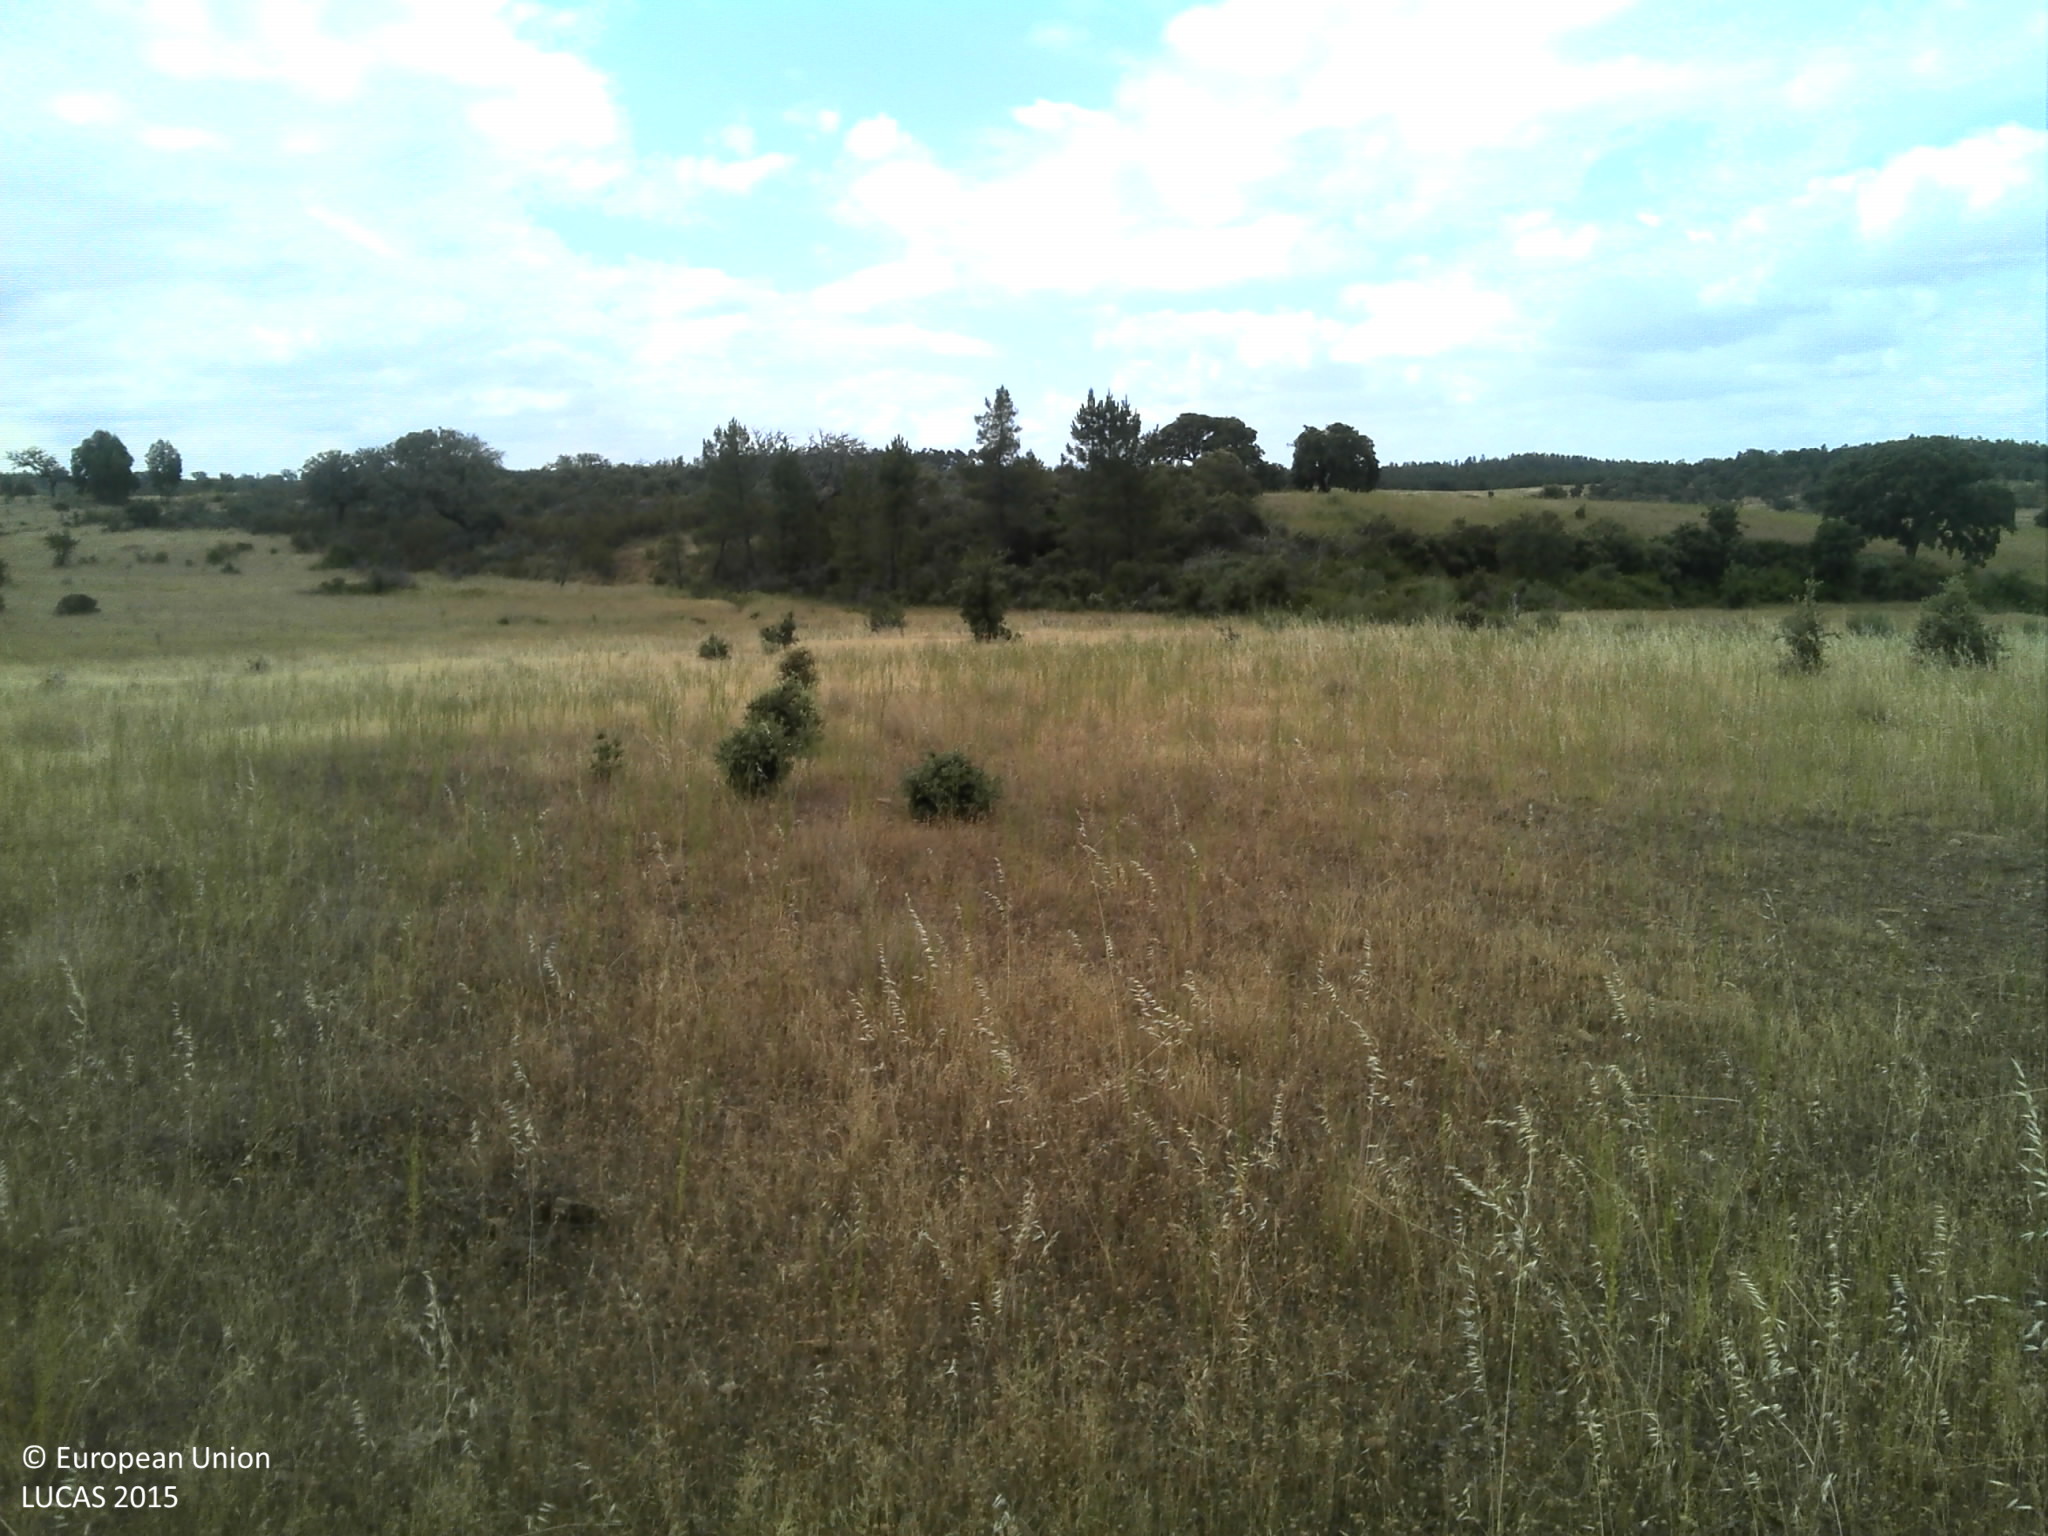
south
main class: Grassland
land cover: Grassland without tree/shrub cover
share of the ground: 50 - 75 %
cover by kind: herbaceous plants 60 %, unconsolidated bare surface 35 %, shrubs 5 %
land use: Agriculture (excluding fallow land and kitchen gardens)
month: June
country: PT
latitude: 40.1430
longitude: -7.2717
